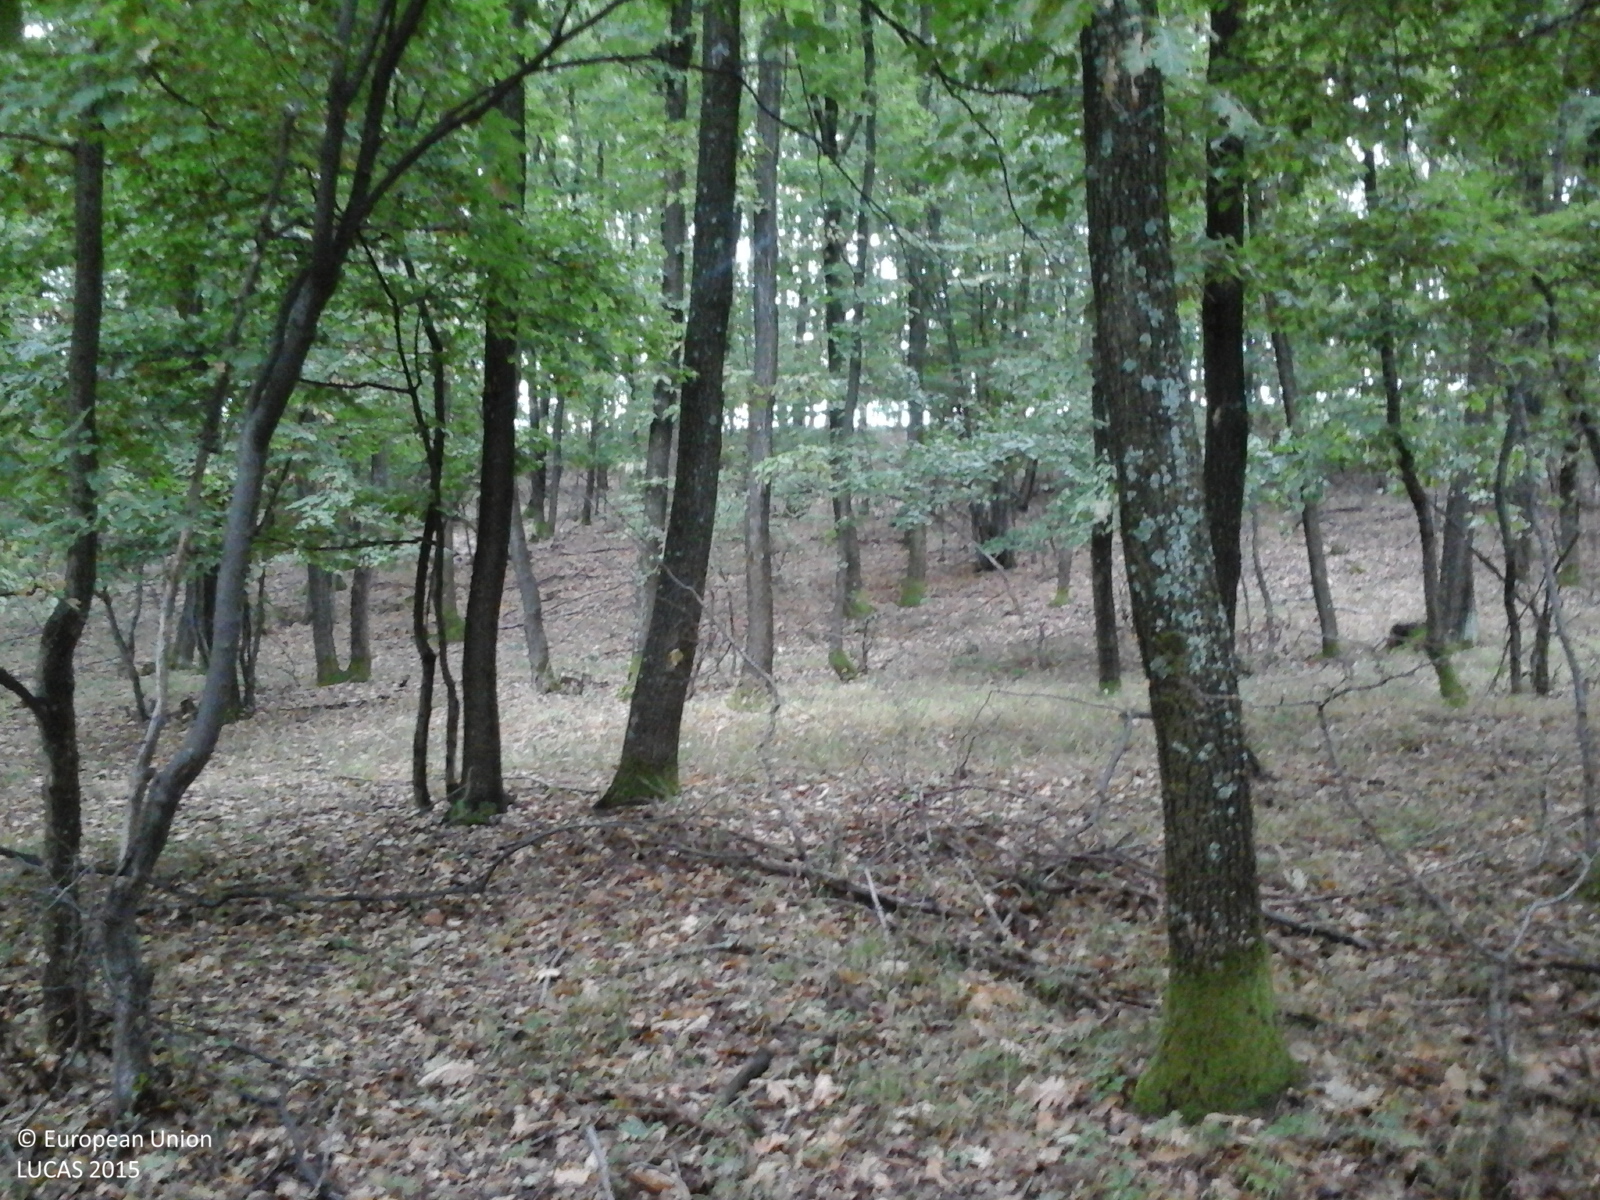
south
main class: Woodland
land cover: Broadleaved woodland
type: acidophilous oak and oak-birch forest
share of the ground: > 75 %
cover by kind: broadleaved forest trees 100 %
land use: Forestry
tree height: > 5 m
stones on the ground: < 10 %
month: August
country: RO
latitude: 44.6050
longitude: 22.8580
